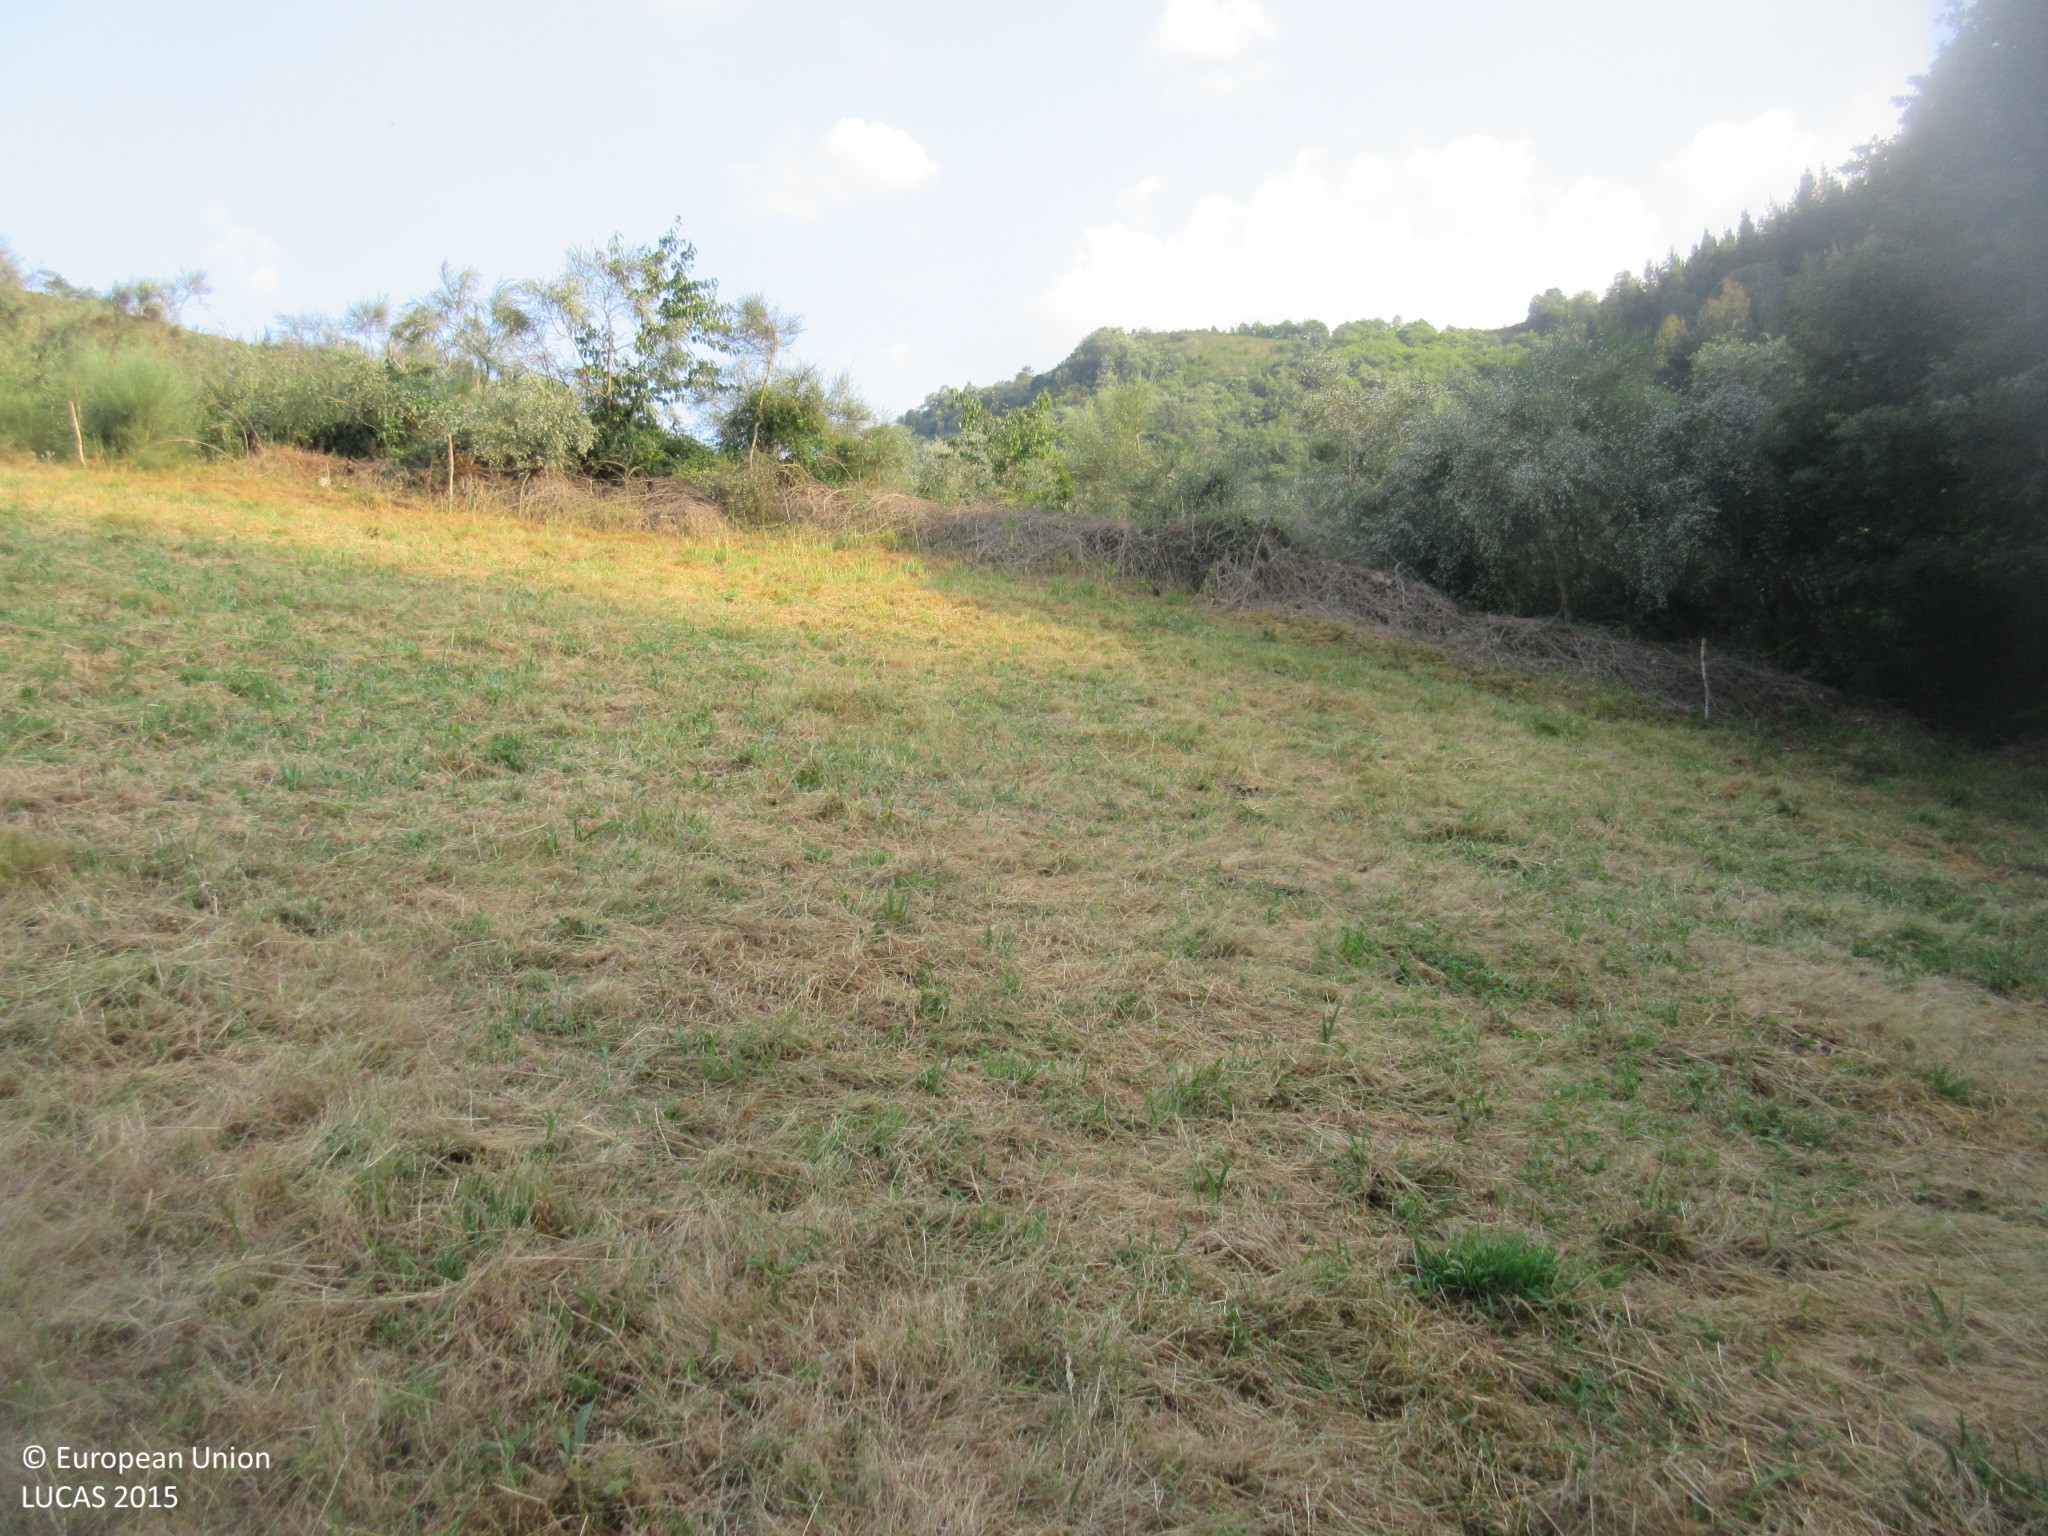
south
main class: Grassland
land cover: Grassland without tree/shrub cover
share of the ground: > 75 %
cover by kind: herbaceous plants 100 %
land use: Agriculture (excluding fallow land and kitchen gardens)
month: June
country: ES
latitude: 42.9379
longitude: -6.9843
